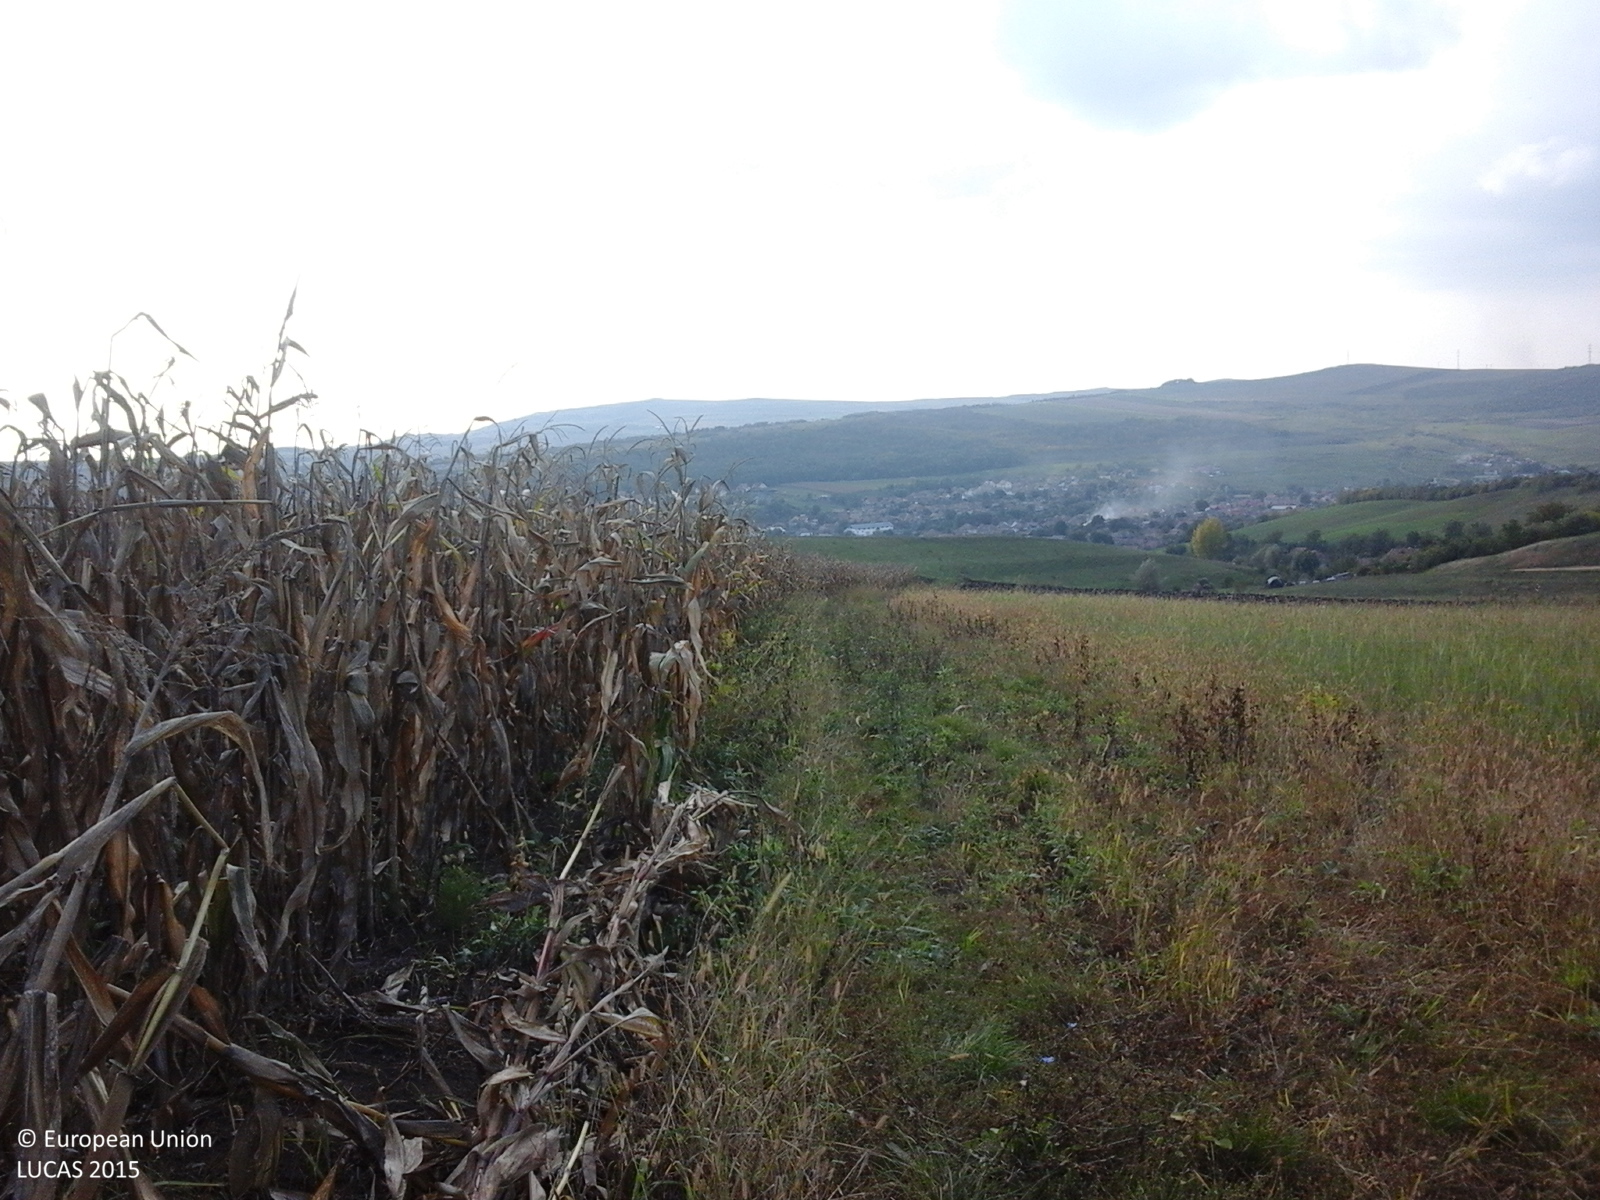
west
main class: Cropland
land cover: Maize
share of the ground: > 75 %
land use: Agriculture (excluding fallow land and kitchen gardens)
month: October
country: RO
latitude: 46.4883
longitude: 24.1095
